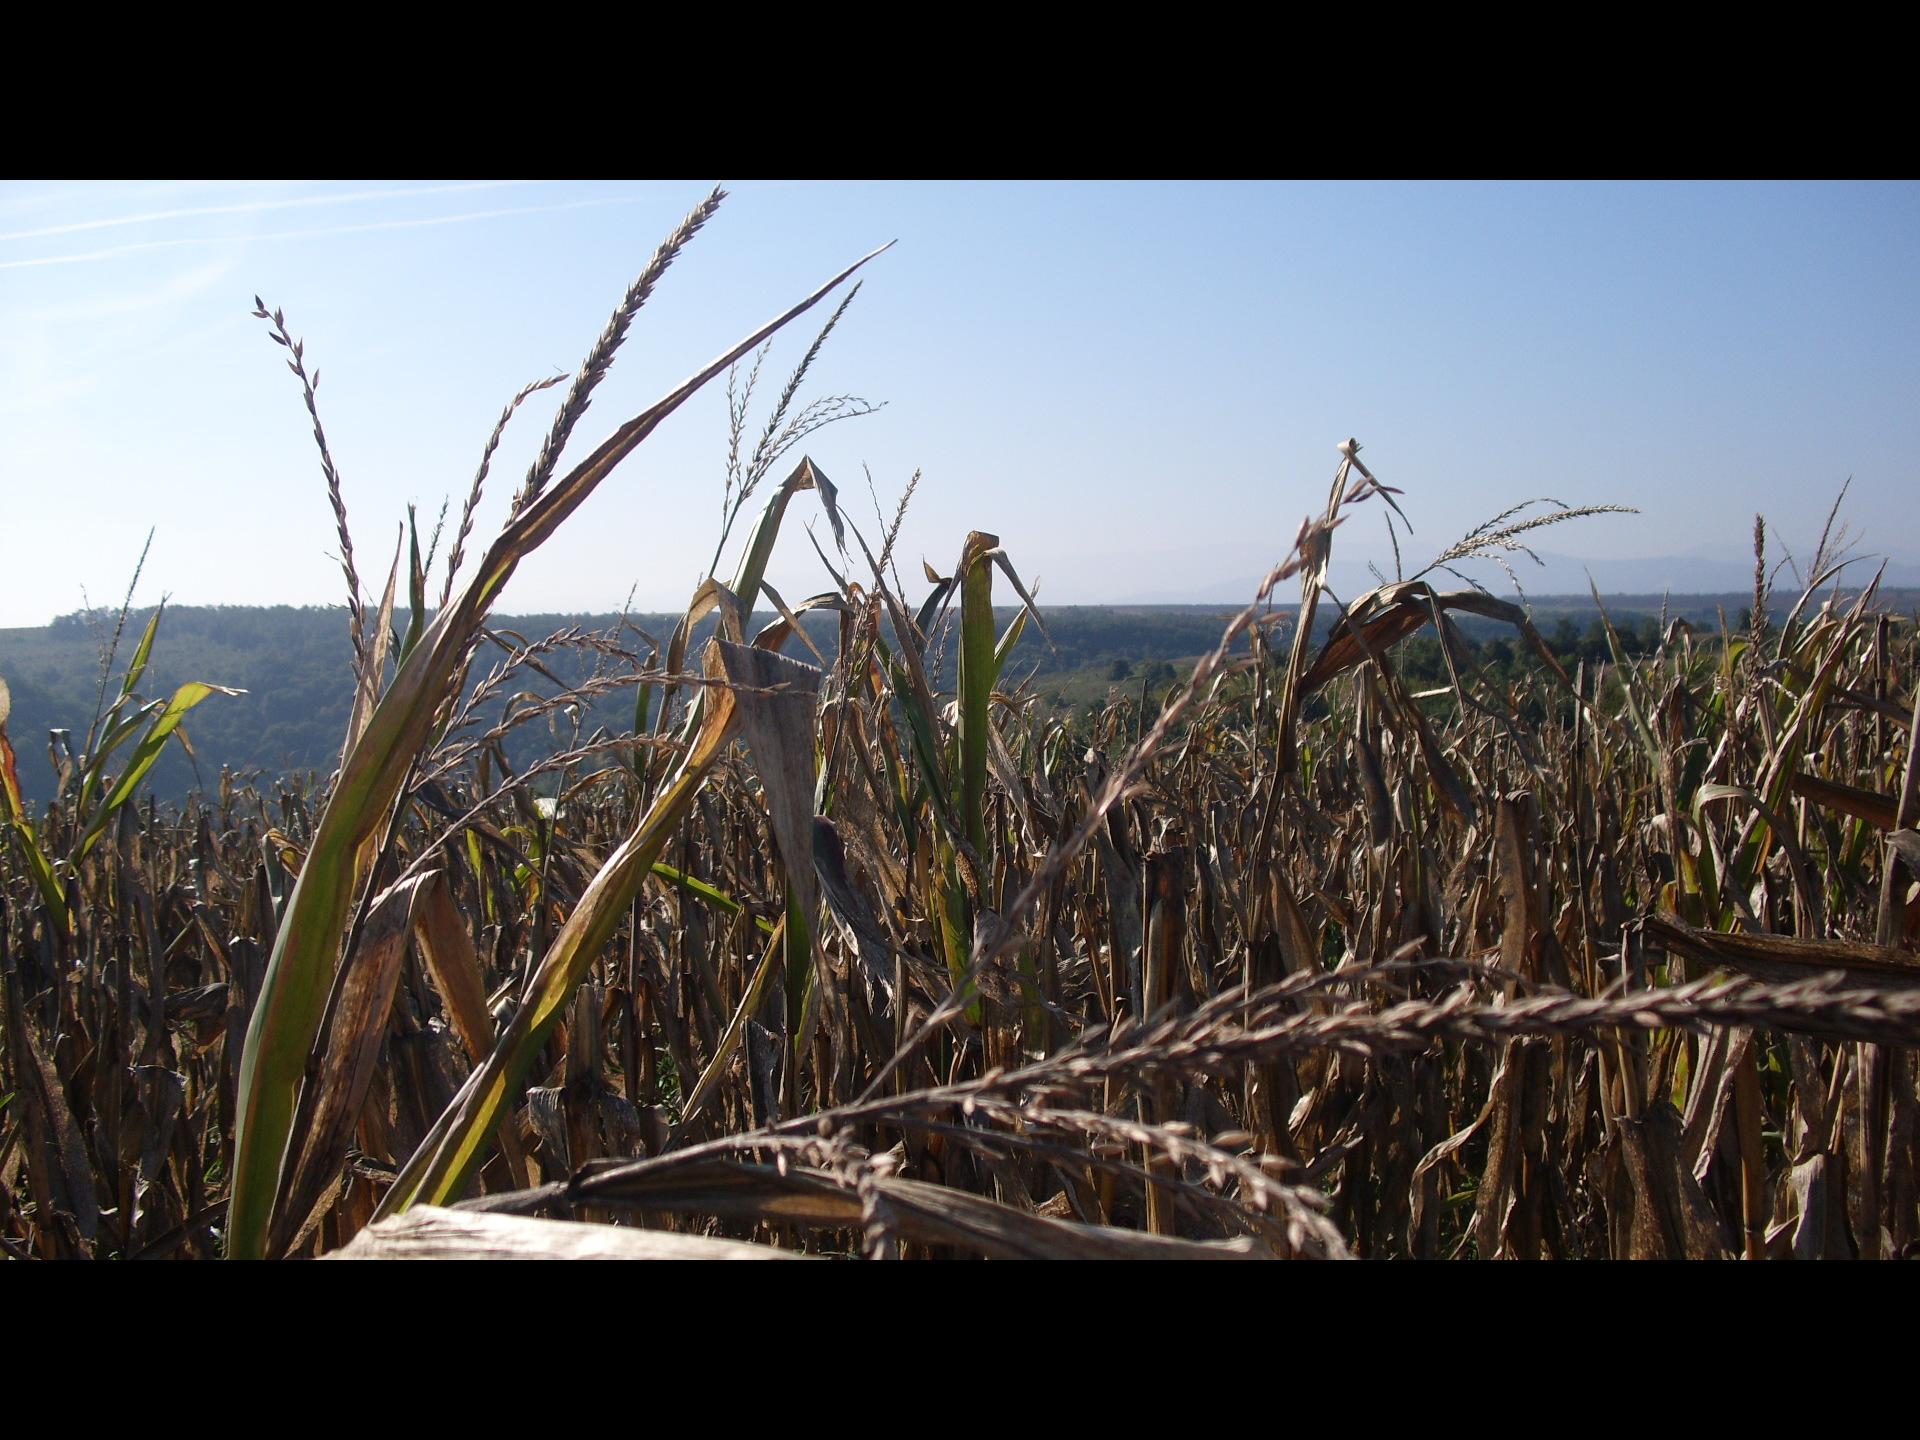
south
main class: Cropland
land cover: Maize
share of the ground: > 75 %
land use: Agriculture (excluding fallow land and kitchen gardens)
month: October
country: BG
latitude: 43.8092
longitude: 22.8038
